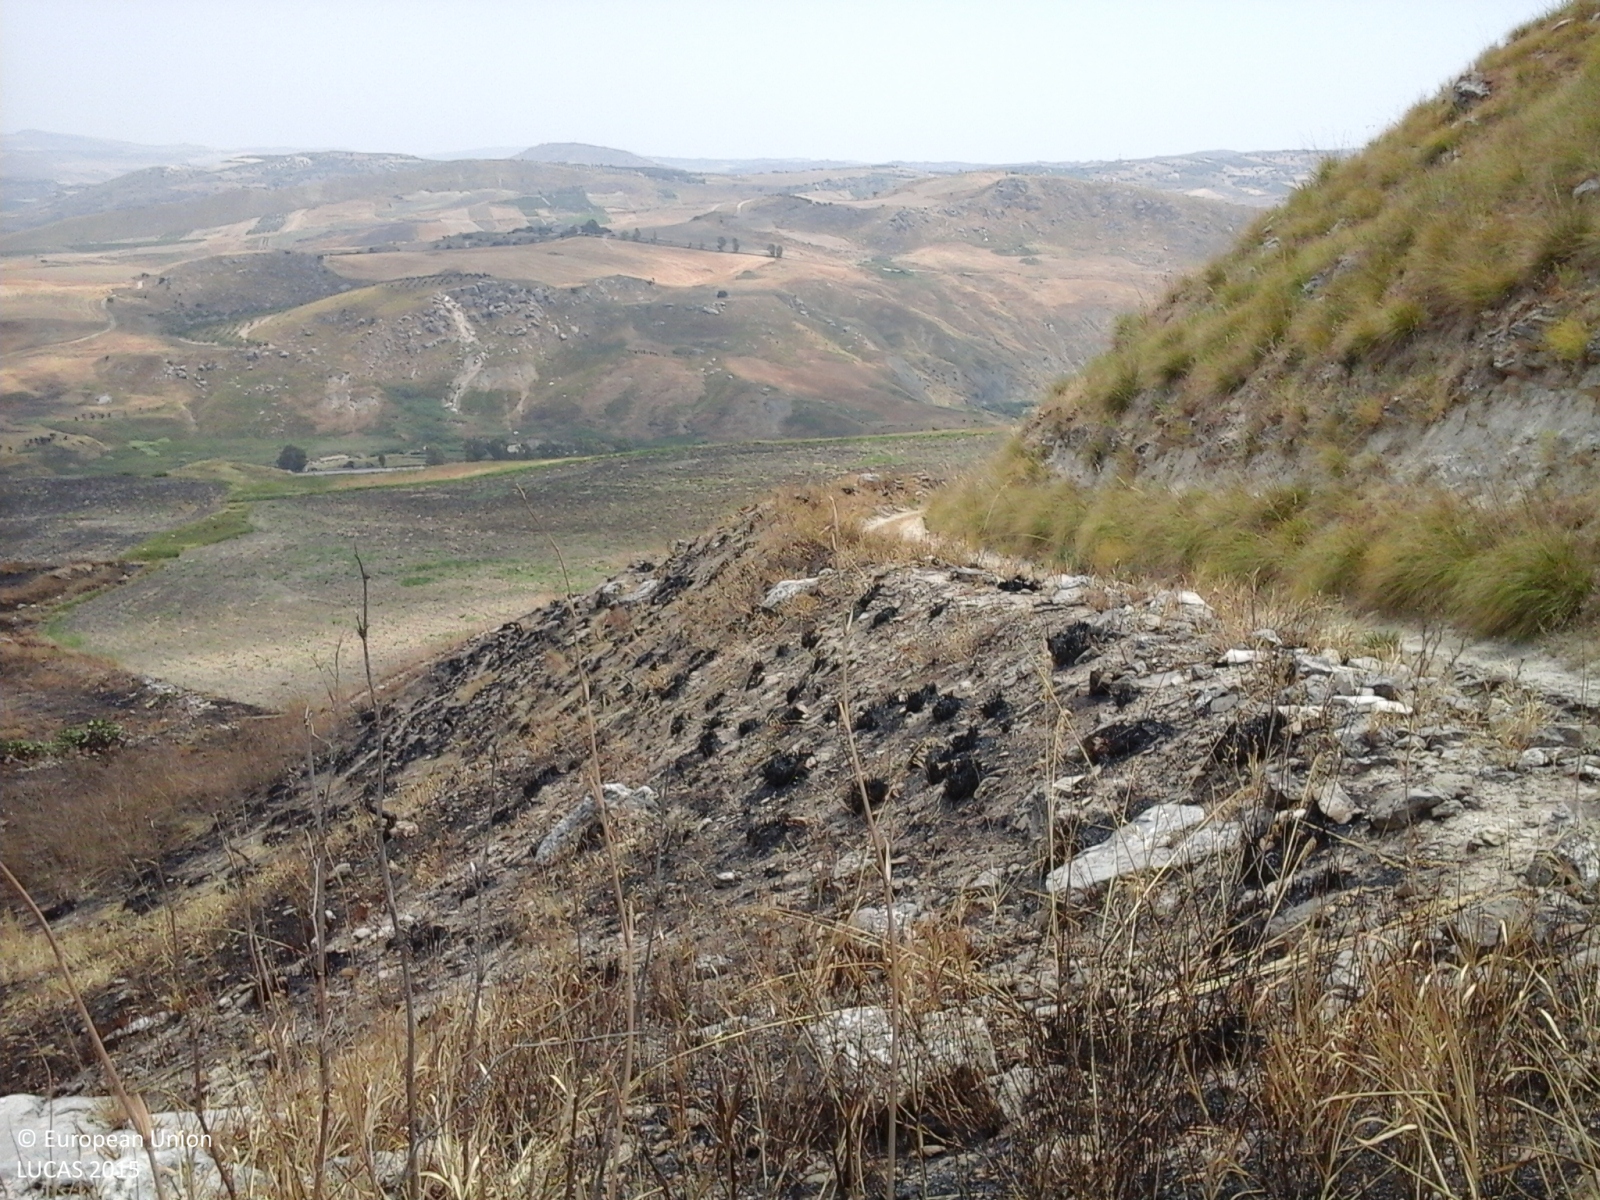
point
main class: Grassland
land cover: Grassland without tree/shrub cover
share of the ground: > 75 %
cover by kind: herbaceous plants 75 %, consolidated bare surface 25 %
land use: Semi-natural and natural areas not in use
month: July
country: IT
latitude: 37.3162
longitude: 14.0424
